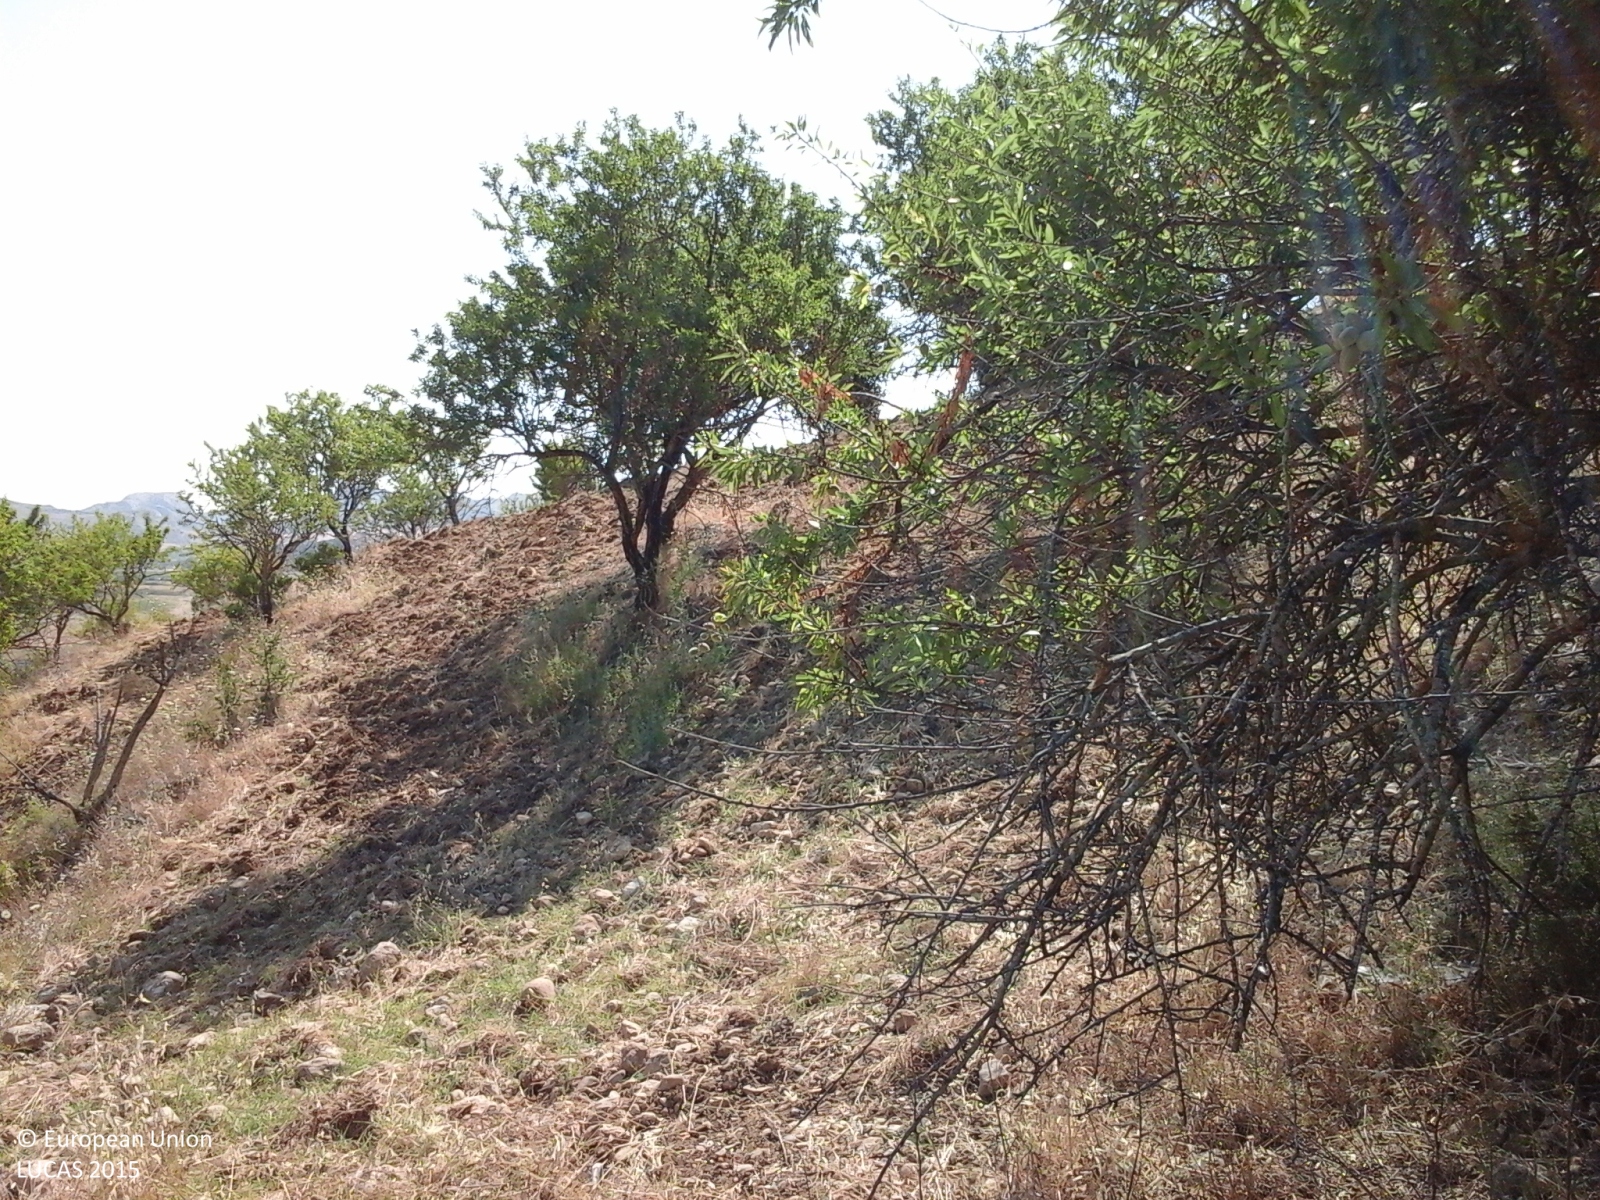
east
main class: Cropland
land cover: Nuts trees
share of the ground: 25 - 50 %
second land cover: Spontaneously vegetated surfaces
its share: > 75 %
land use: Agriculture (excluding fallow land and kitchen gardens)
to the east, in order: Nuts trees; Spontaneously vegetated surfaces; Olive groves; Grass margins; Olive groves; Grass margins
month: July
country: IT
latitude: 37.4473
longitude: 13.4886
